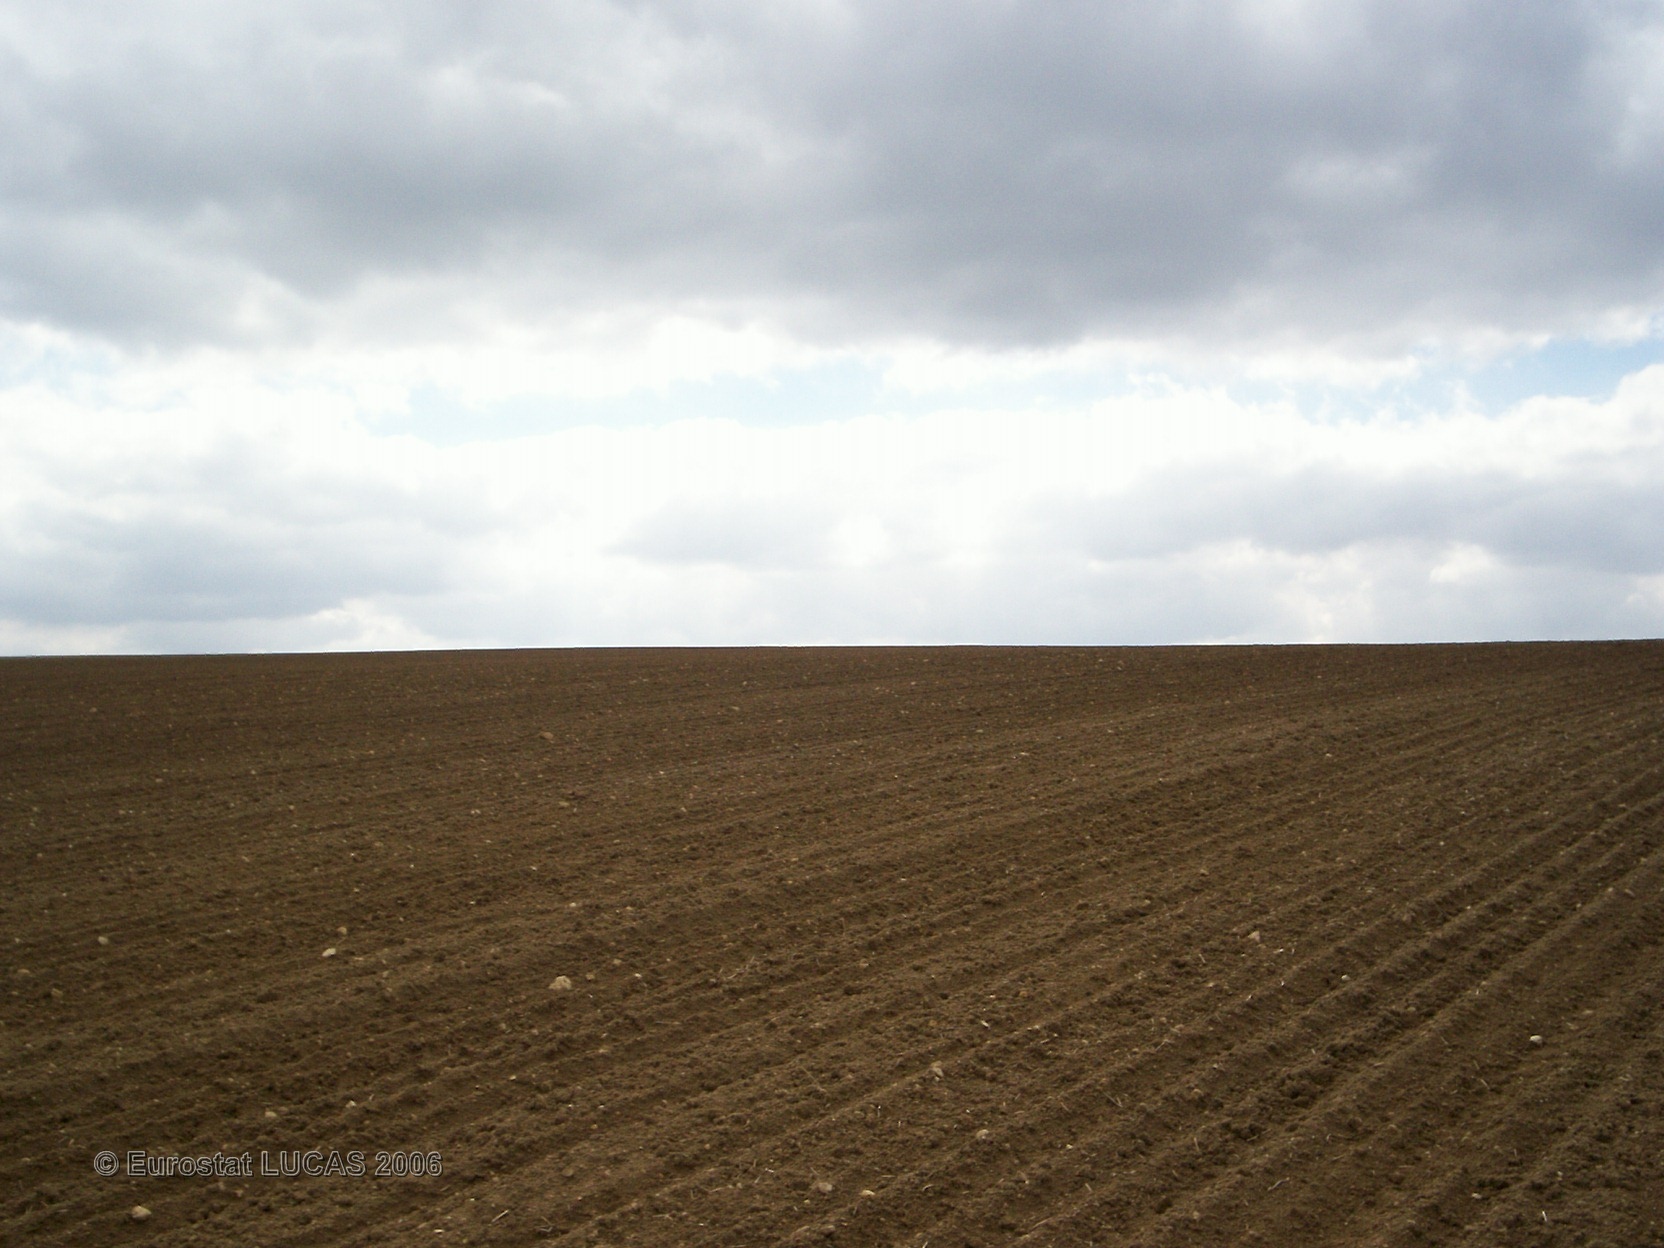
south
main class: Cropland
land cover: Sugar beet
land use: Agriculture (excluding fallow land and kitchen gardens)
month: April
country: FR
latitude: 49.4502
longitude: 3.6898
